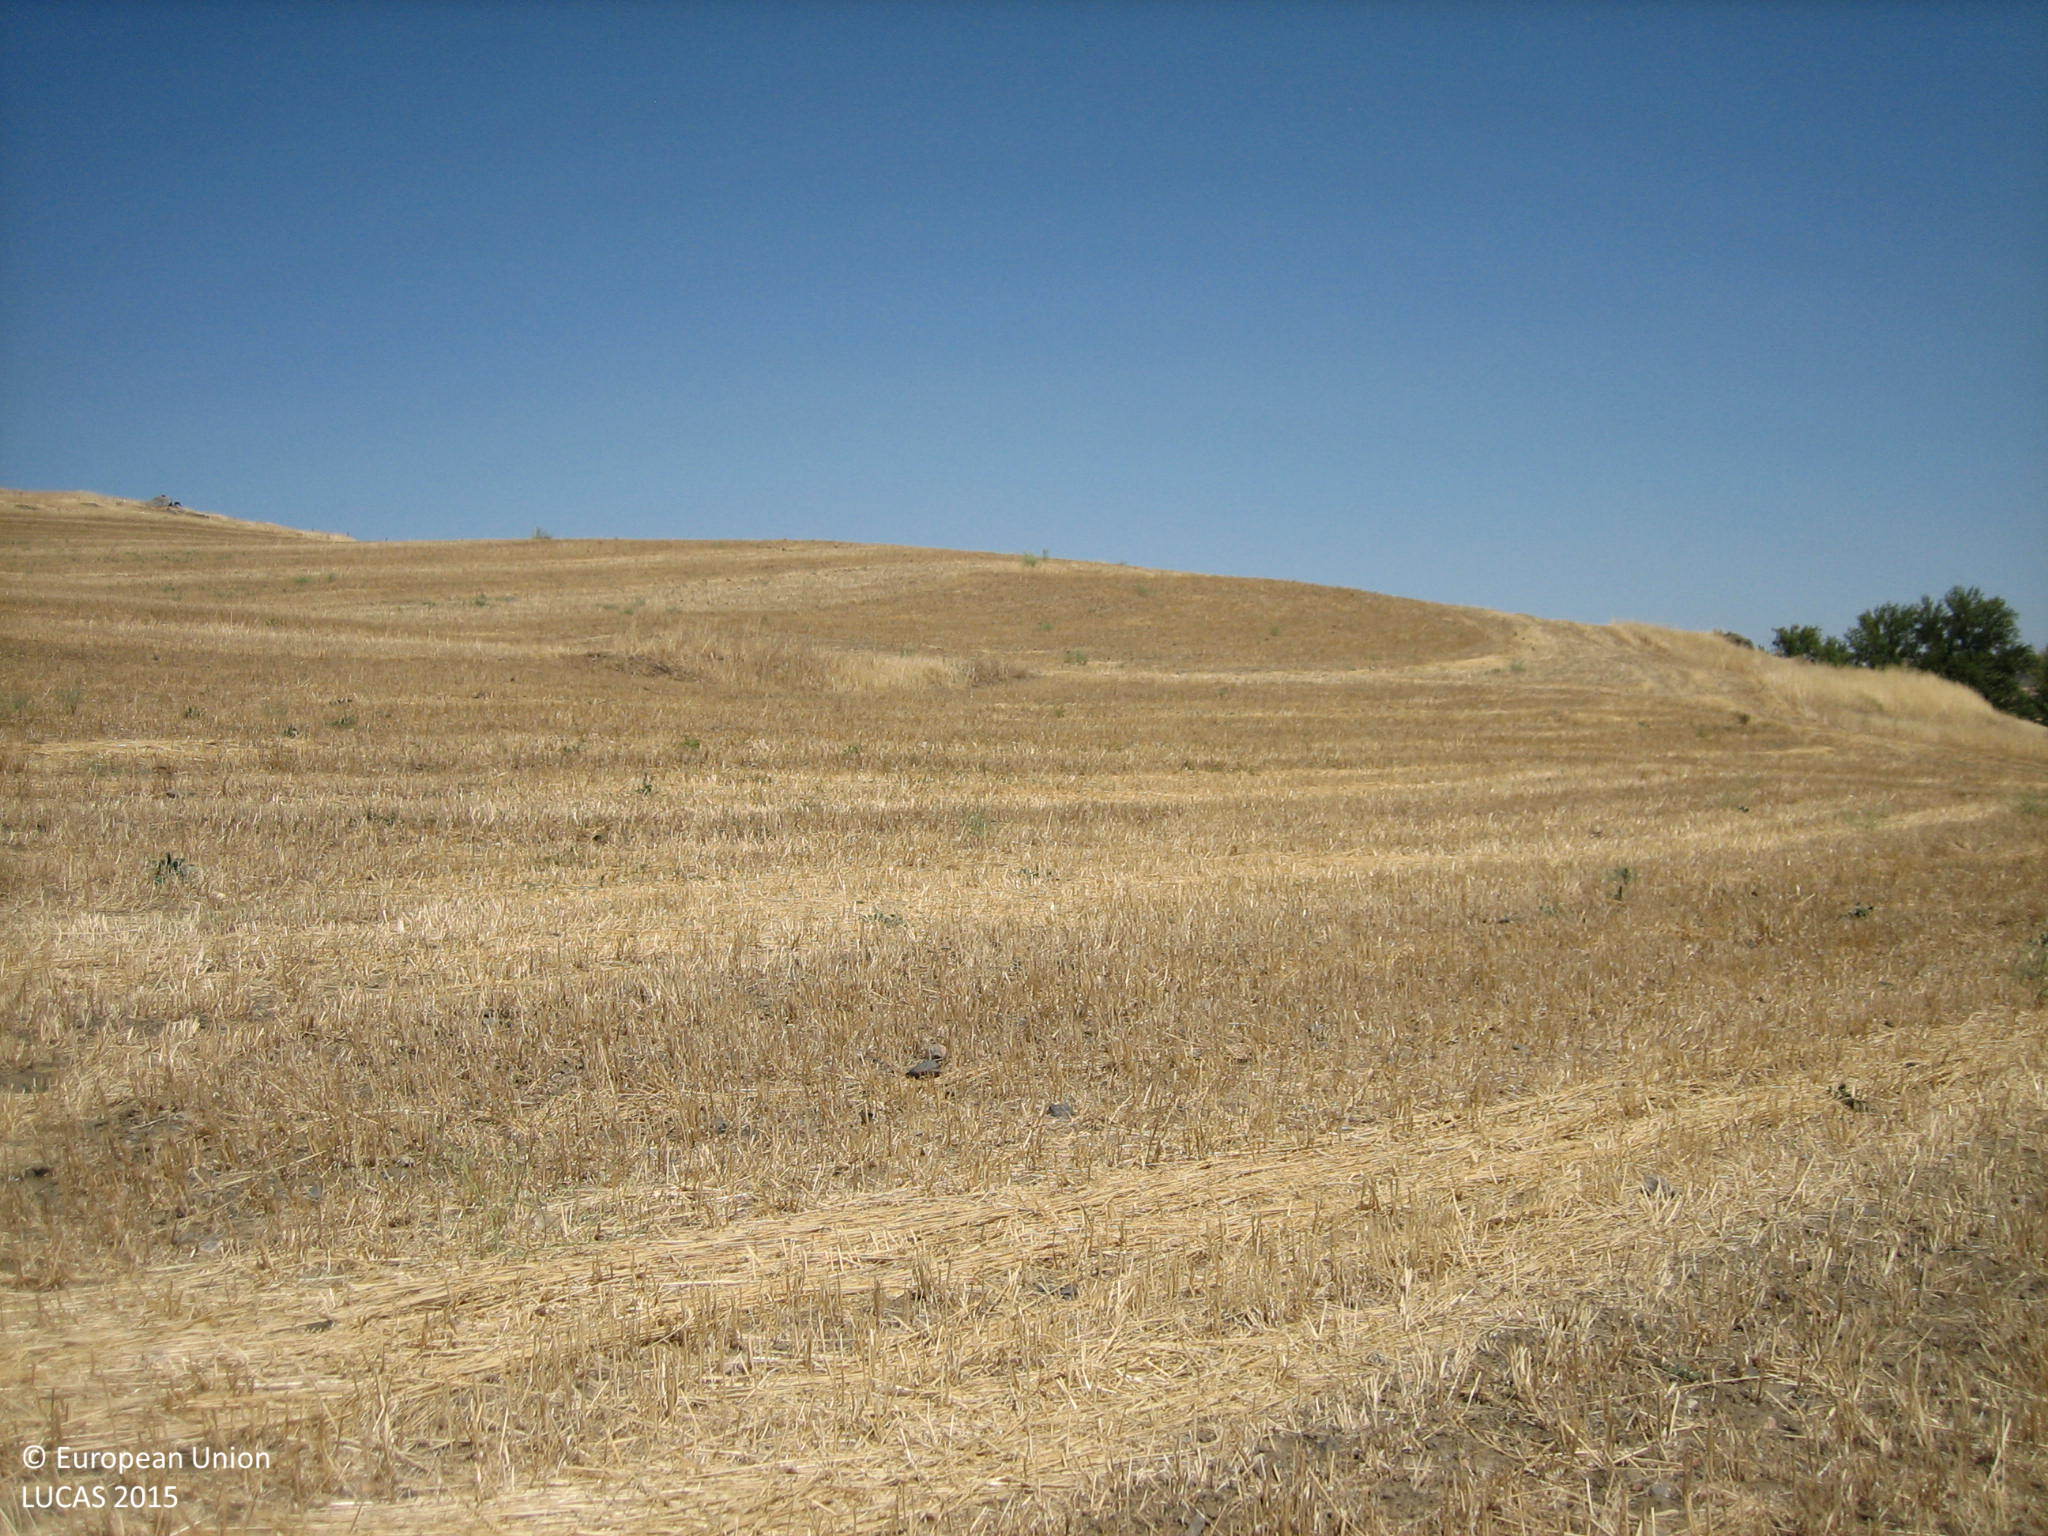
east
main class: Cropland
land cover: Common wheat
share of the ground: < 10 %
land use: Agriculture (excluding fallow land and kitchen gardens)
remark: Harvested field
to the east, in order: Common wheat; Grassland without tree/shrub cover; Fences; Other leguminous and mixtures for fodder
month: July
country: ES
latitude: 38.1635
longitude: -6.2612
